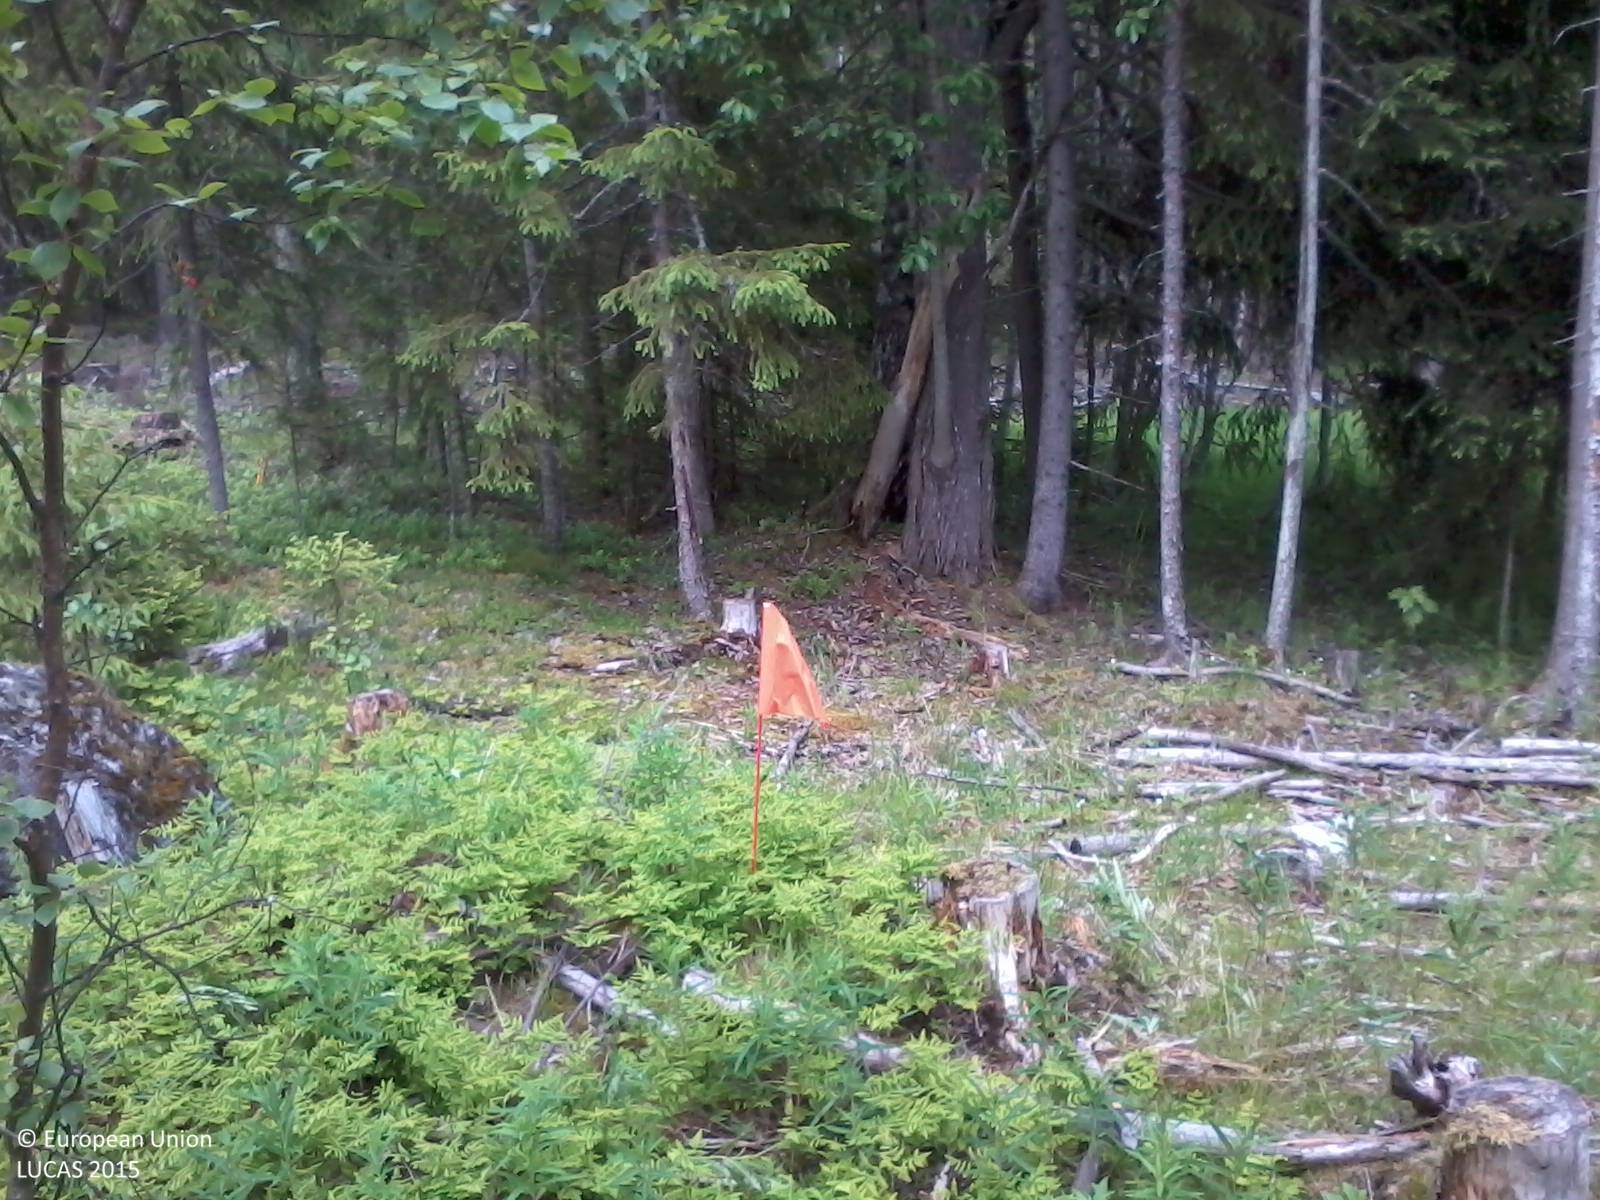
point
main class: Woodland
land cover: Spruce dominated mixed woodland
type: boreal forest
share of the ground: 50 - 75 %
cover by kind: coniferous forest trees 35 %, herbaceous plants 35 %, broadleaved forest trees 15 %, shrubs 15 %
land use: Forestry
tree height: > 5 m
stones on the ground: < 10 %
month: June
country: SE
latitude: 63.4729
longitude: 17.9422
